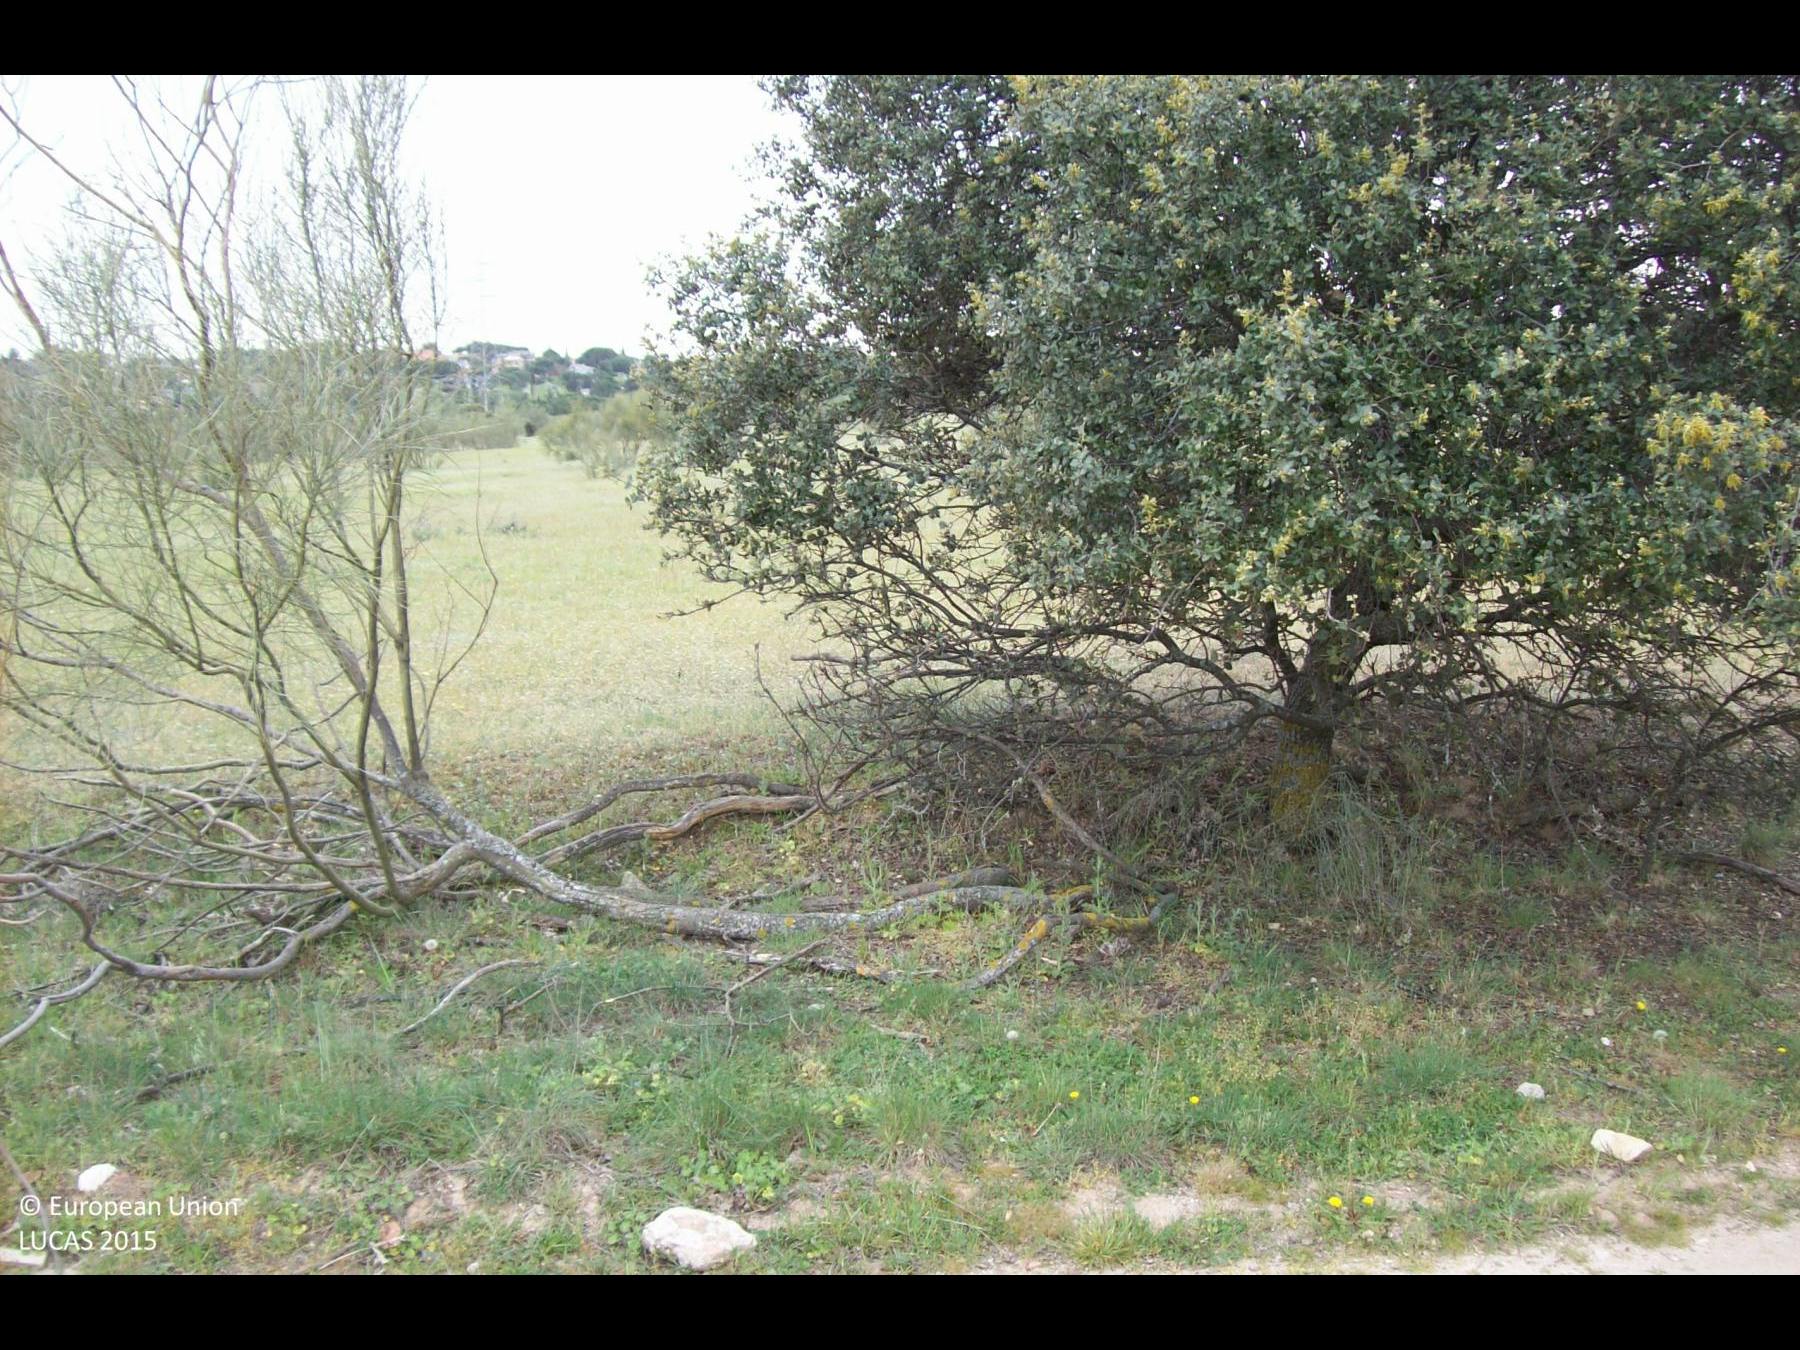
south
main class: Grassland
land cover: Grassland with sparse tree/shrub cover
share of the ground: > 75 %
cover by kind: herbaceous plants 75 %, broadleaved forest trees 5 %, shrubs 5 %
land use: Semi-natural and natural areas not in use
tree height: < 5 m
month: April
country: ES
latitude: 40.4429
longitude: -3.9174
